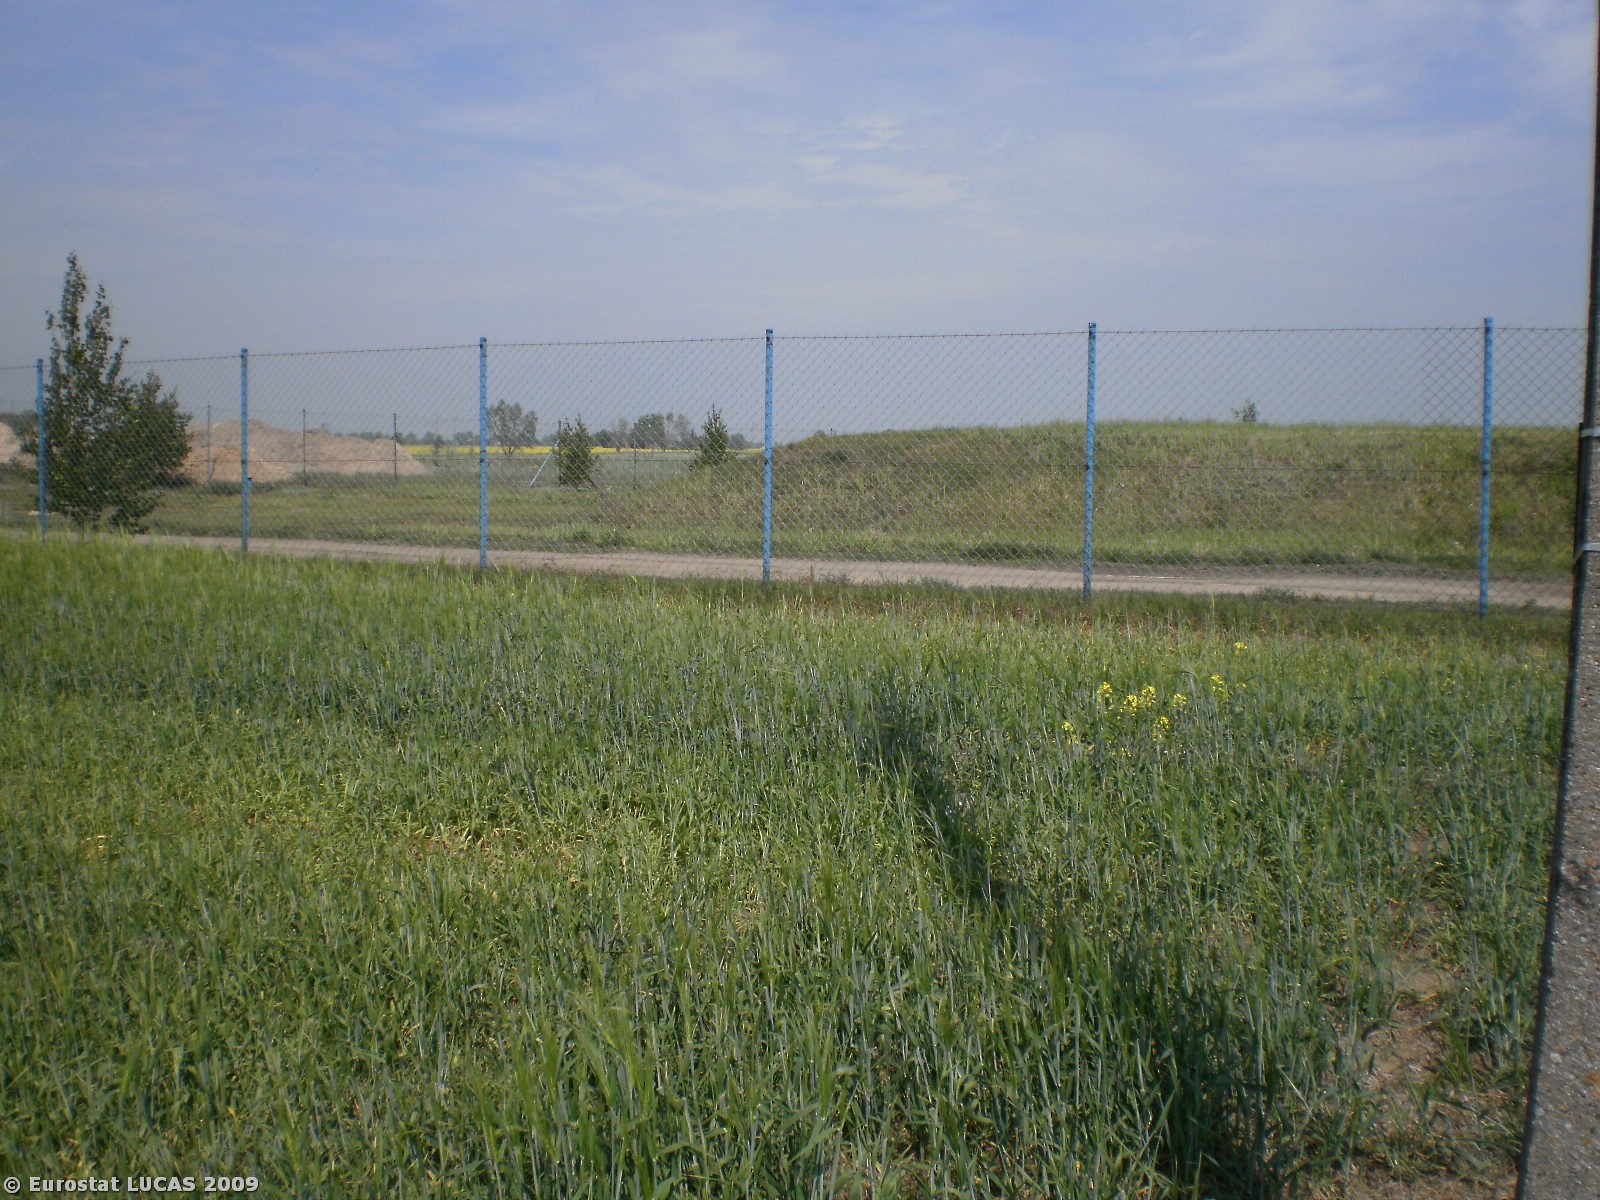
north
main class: Cropland
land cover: Barley
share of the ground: > 75 %
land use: Agriculture (excluding fallow land and kitchen gardens)
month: May
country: PL
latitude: 53.3363
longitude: 18.2614
